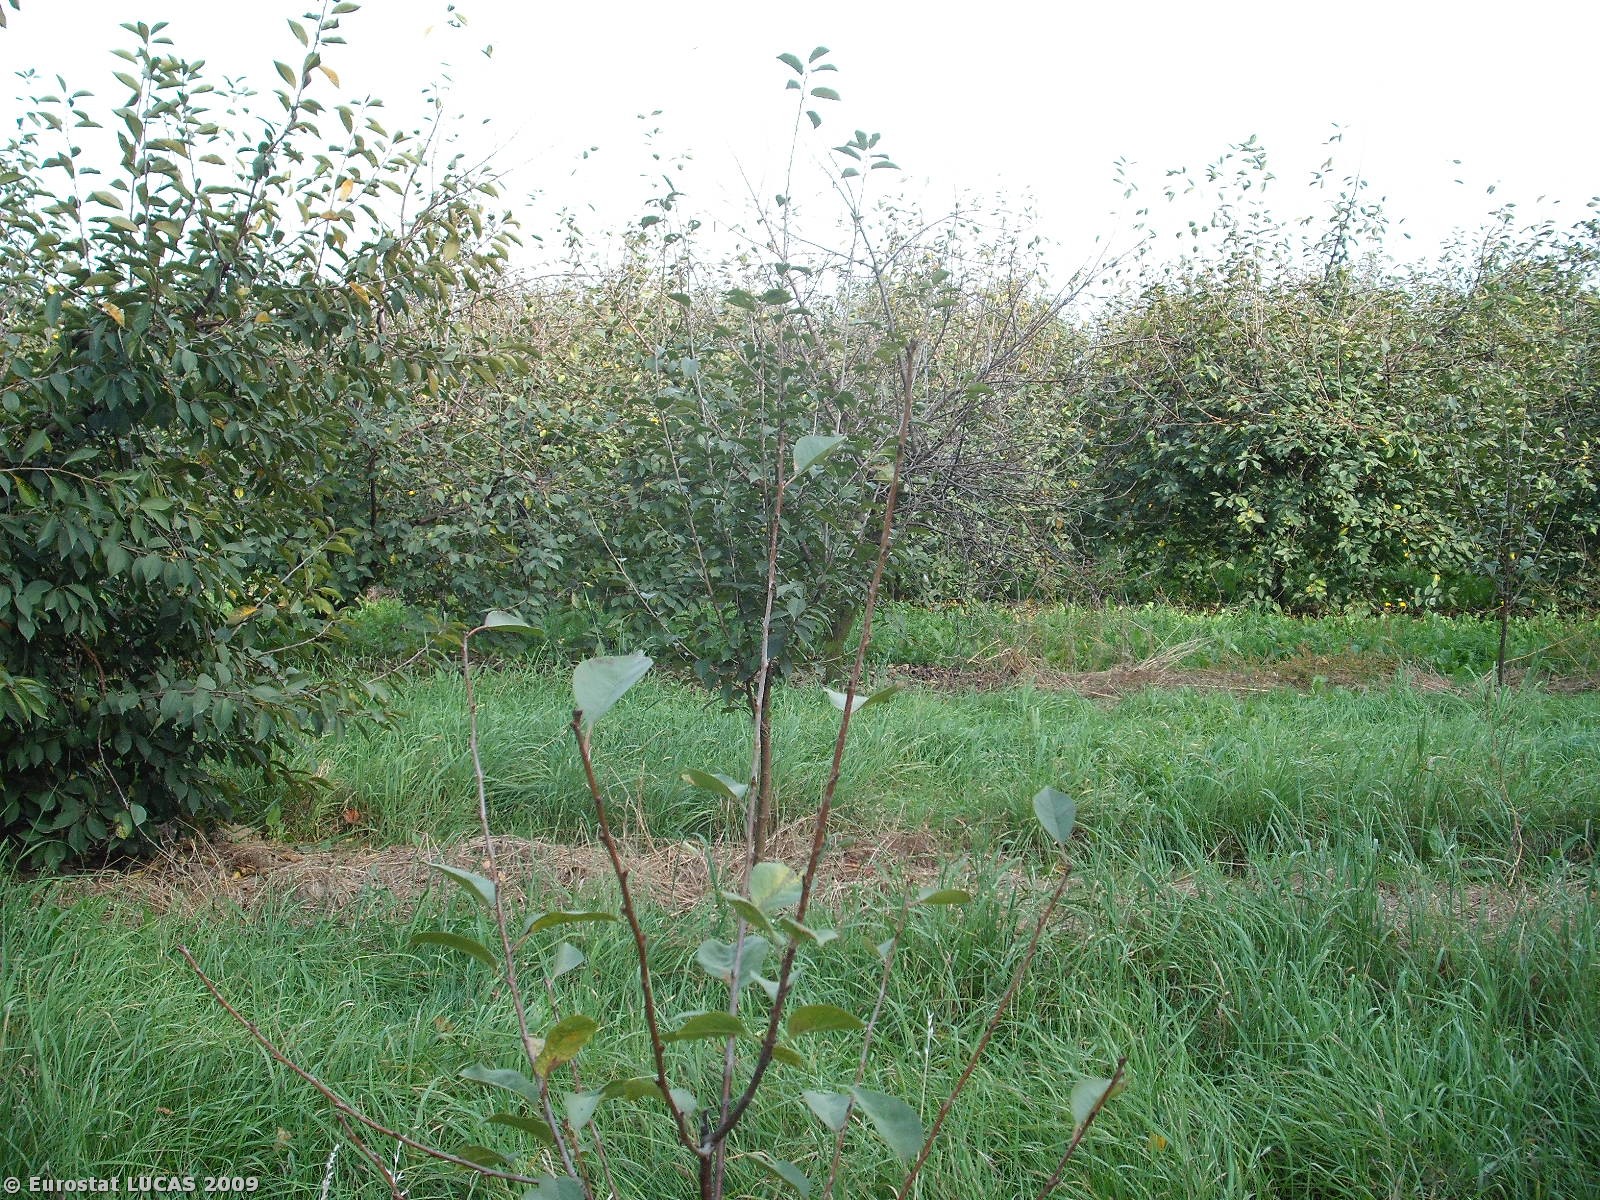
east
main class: Cropland
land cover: Cherry fruit
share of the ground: 50 - 75 %
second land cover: Grassland with sparse tree/shrub cover
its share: > 75 %
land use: Agriculture (excluding fallow land and kitchen gardens)
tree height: < 5 m
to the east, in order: Cherry fruit; Grassland with sparse tree/shrub cover; Tracks; Apple fruit; Grassland with sparse tree/shrub cover; Grass margins; Potatoes; Tracks; Cherry fruit; Grassland with sparse tree/shrub cover; Apple fruit; Grassland with sparse tree/shrub cover; Cherry fruit; Grassland with sparse tree/shrub cover; Grass margins; Potatoes; Grass margins; Rye
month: September
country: PL
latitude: 51.6649
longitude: 20.6084
